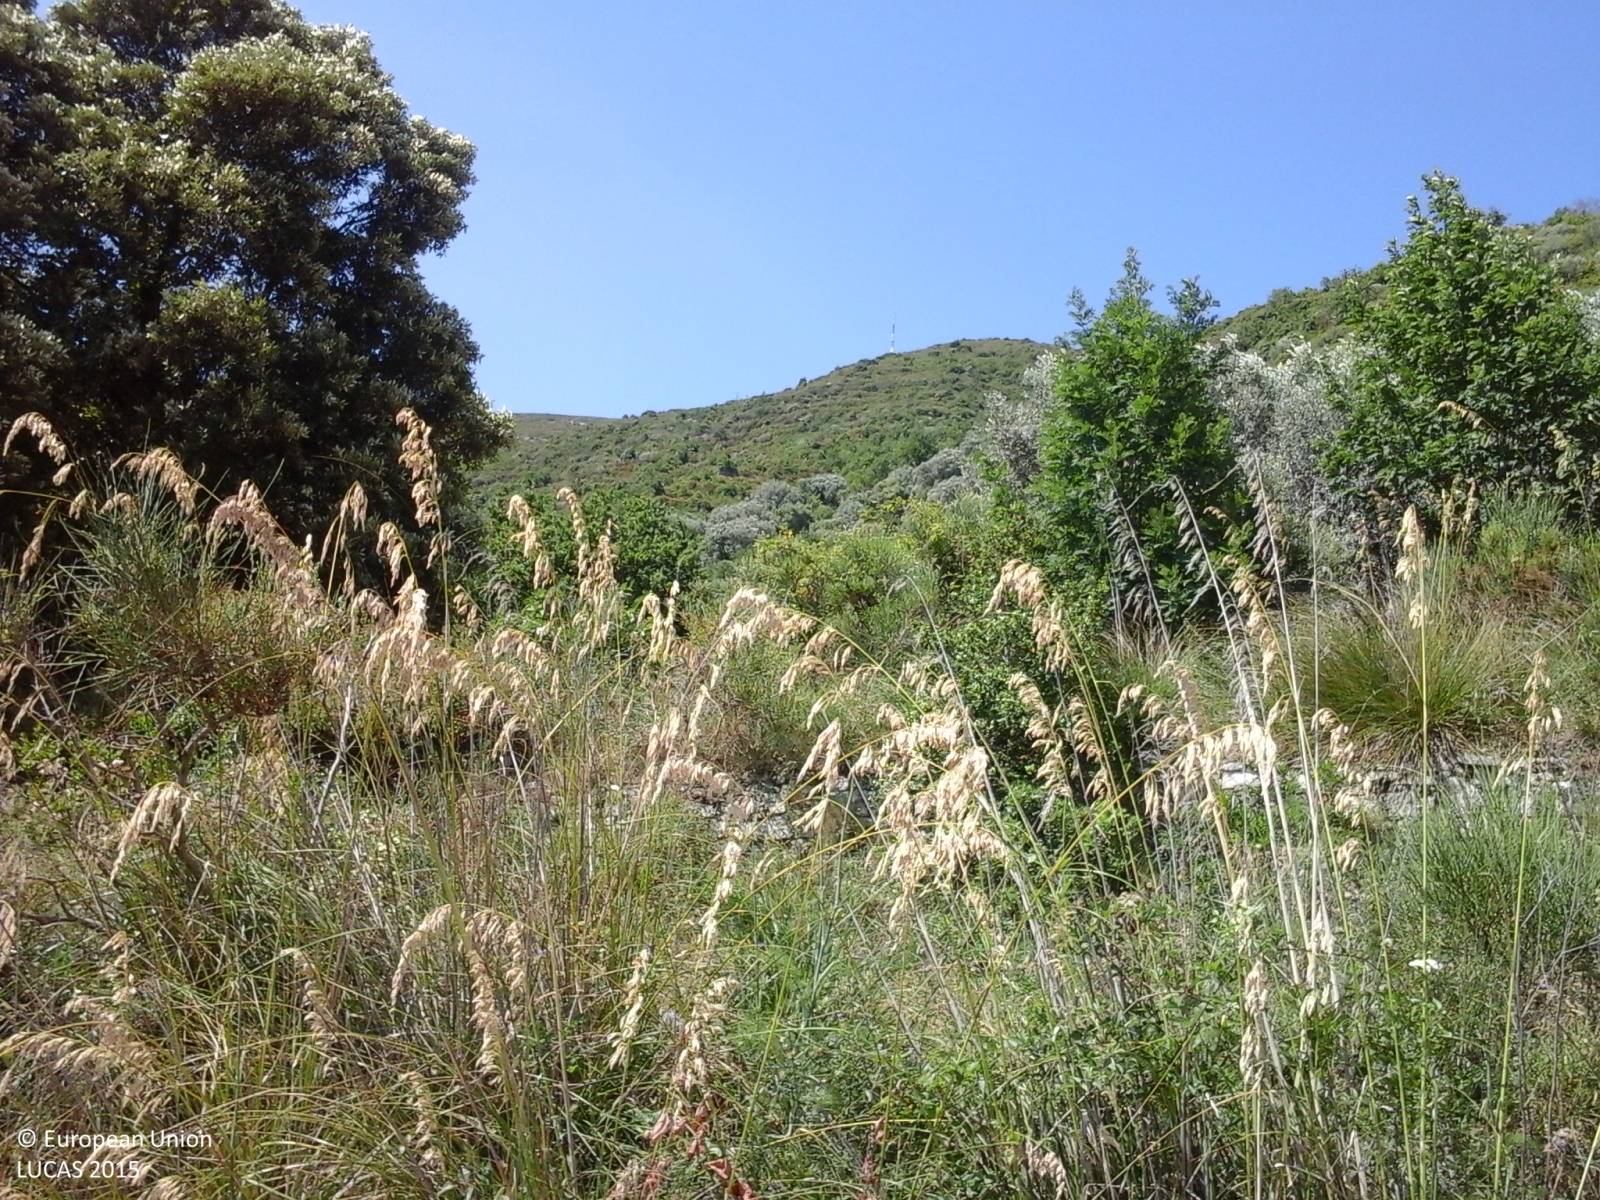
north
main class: Shrubland
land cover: Shrubland with sparse tree cover
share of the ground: > 75 %
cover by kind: shrubs 95 %, broadleaved forest trees 5 %
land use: Semi-natural and natural areas not in use
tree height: > 5 m
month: June
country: IT
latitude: 40.2475
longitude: 15.0208
